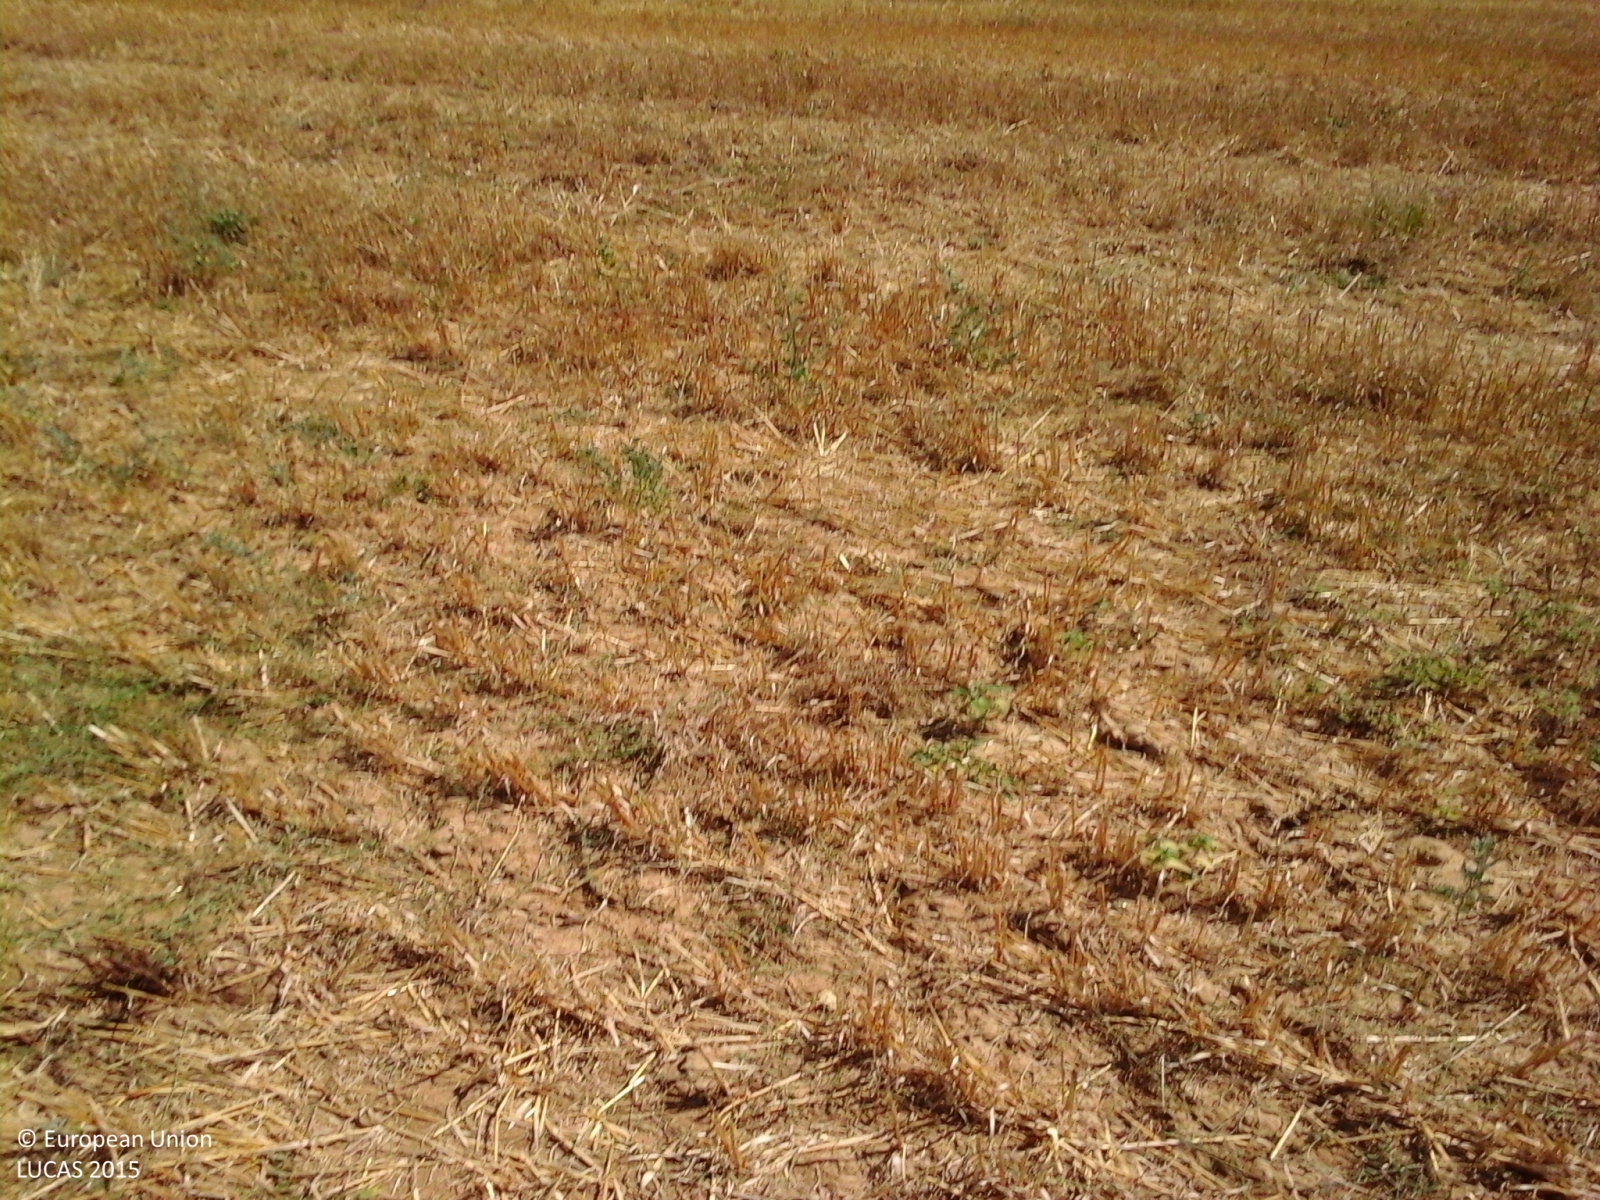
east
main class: Cropland
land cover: Barley
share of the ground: > 75 %
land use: Agriculture (excluding fallow land and kitchen gardens)
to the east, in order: Barley; Other bare soil; Abandoned hedges; Rivers and streams; Abandoned hedges; Arable land (only in case pi)
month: August
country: IT
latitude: 42.5354
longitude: 11.4439
